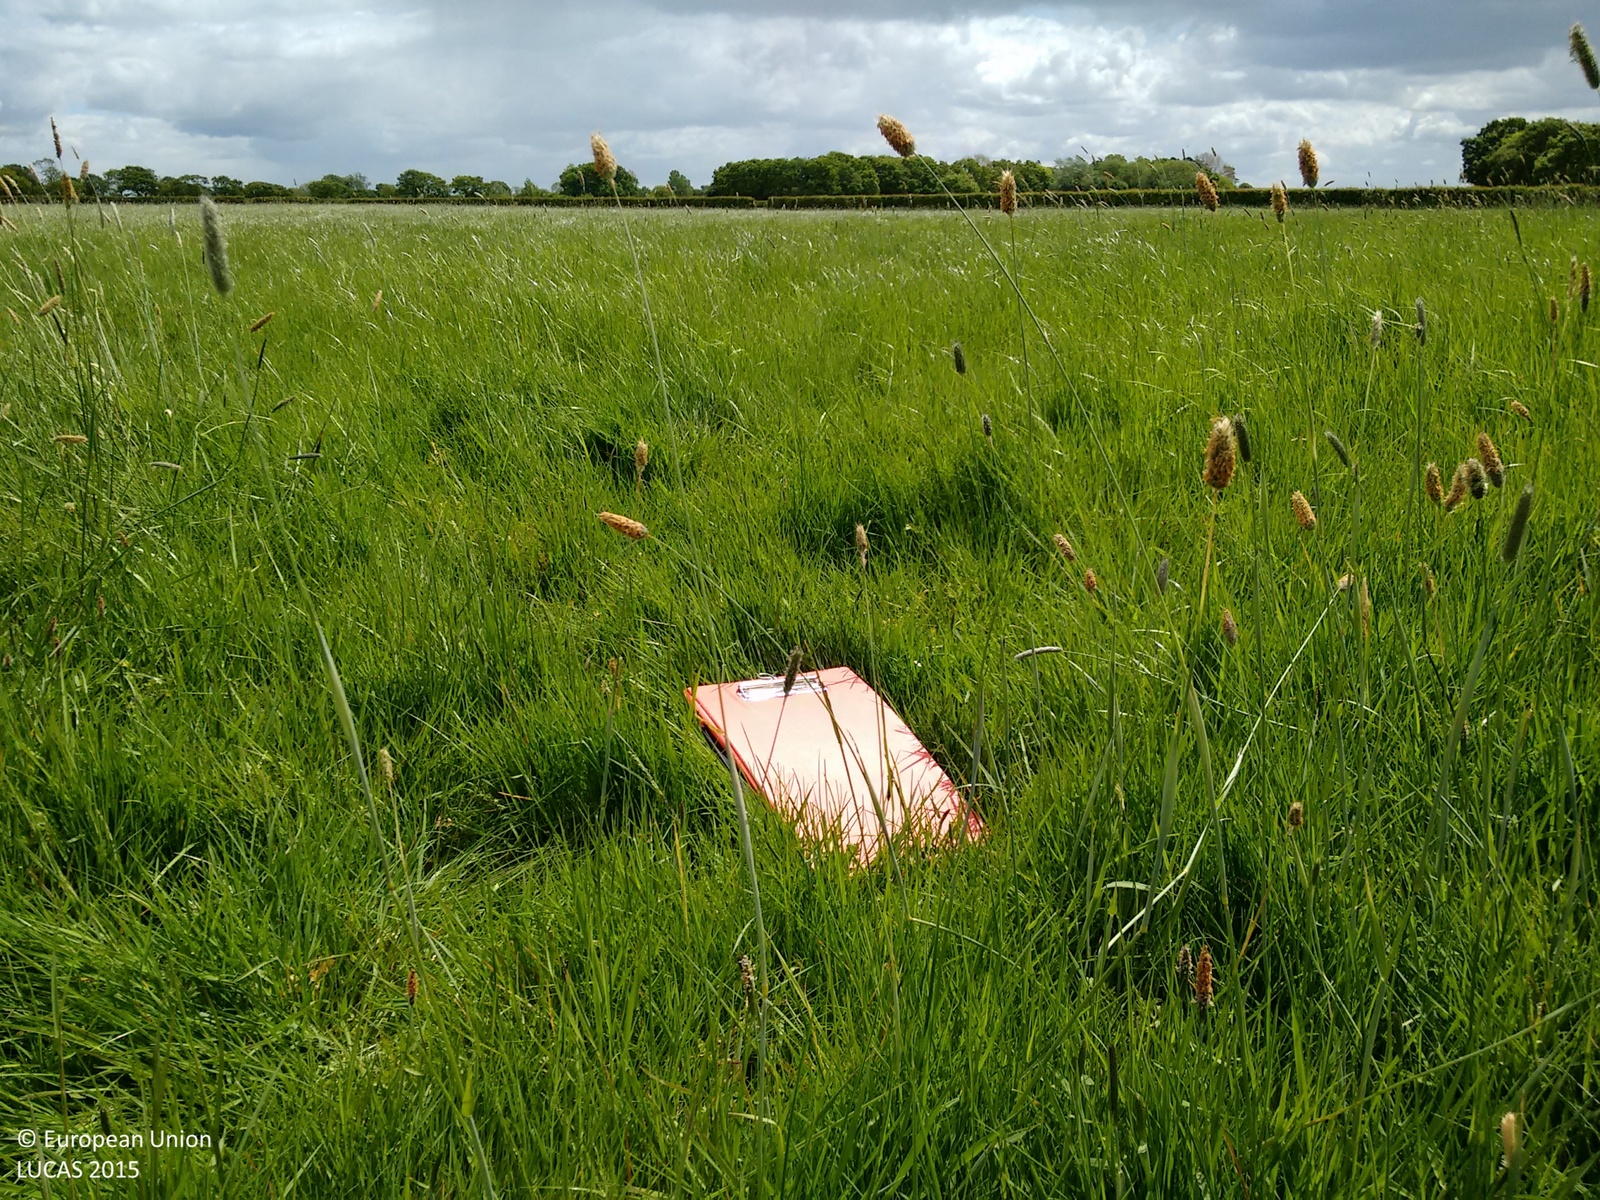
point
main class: Grassland
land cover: Grassland without tree/shrub cover
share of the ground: > 75 %
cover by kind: herbaceous plants 100 %
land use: Agriculture (excluding fallow land and kitchen gardens)
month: May
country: GB
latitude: 53.9683
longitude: -1.2195
